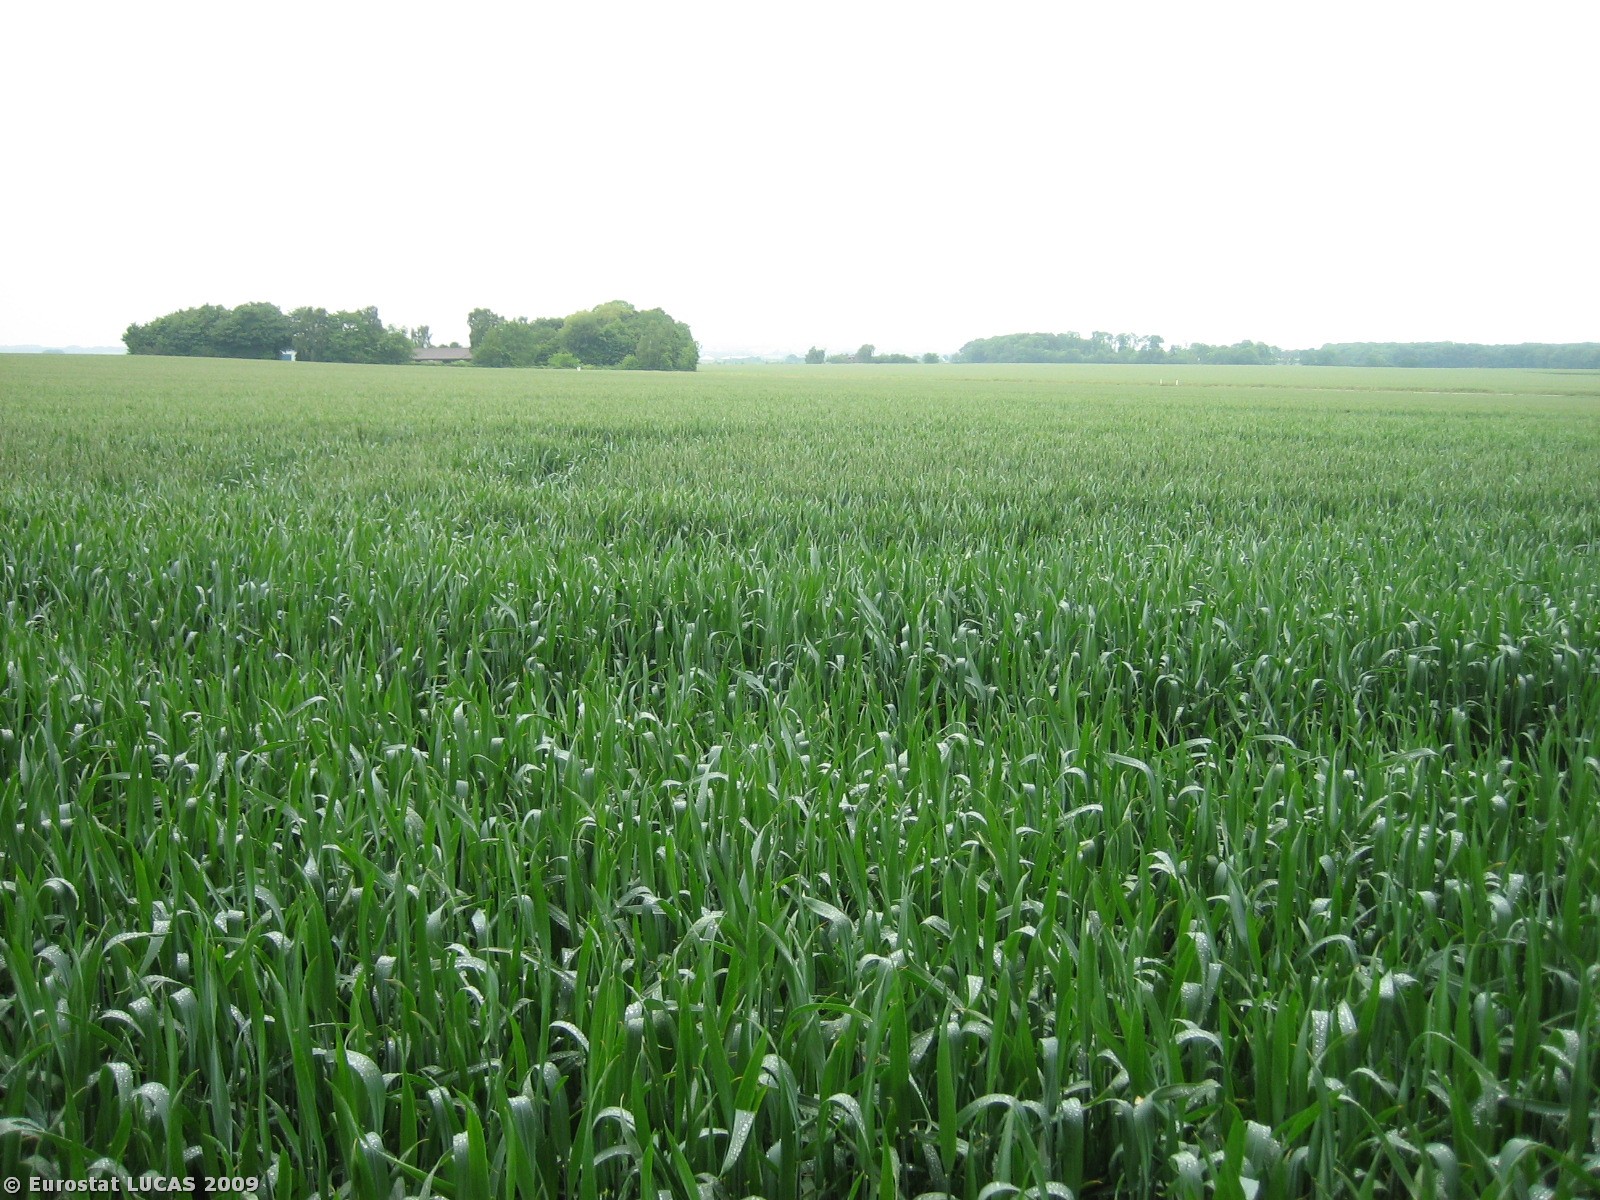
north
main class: Cropland
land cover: Common wheat
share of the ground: > 75 %
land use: Agriculture (excluding fallow land and kitchen gardens)
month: June
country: DK
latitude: 55.9719
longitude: 10.2081
